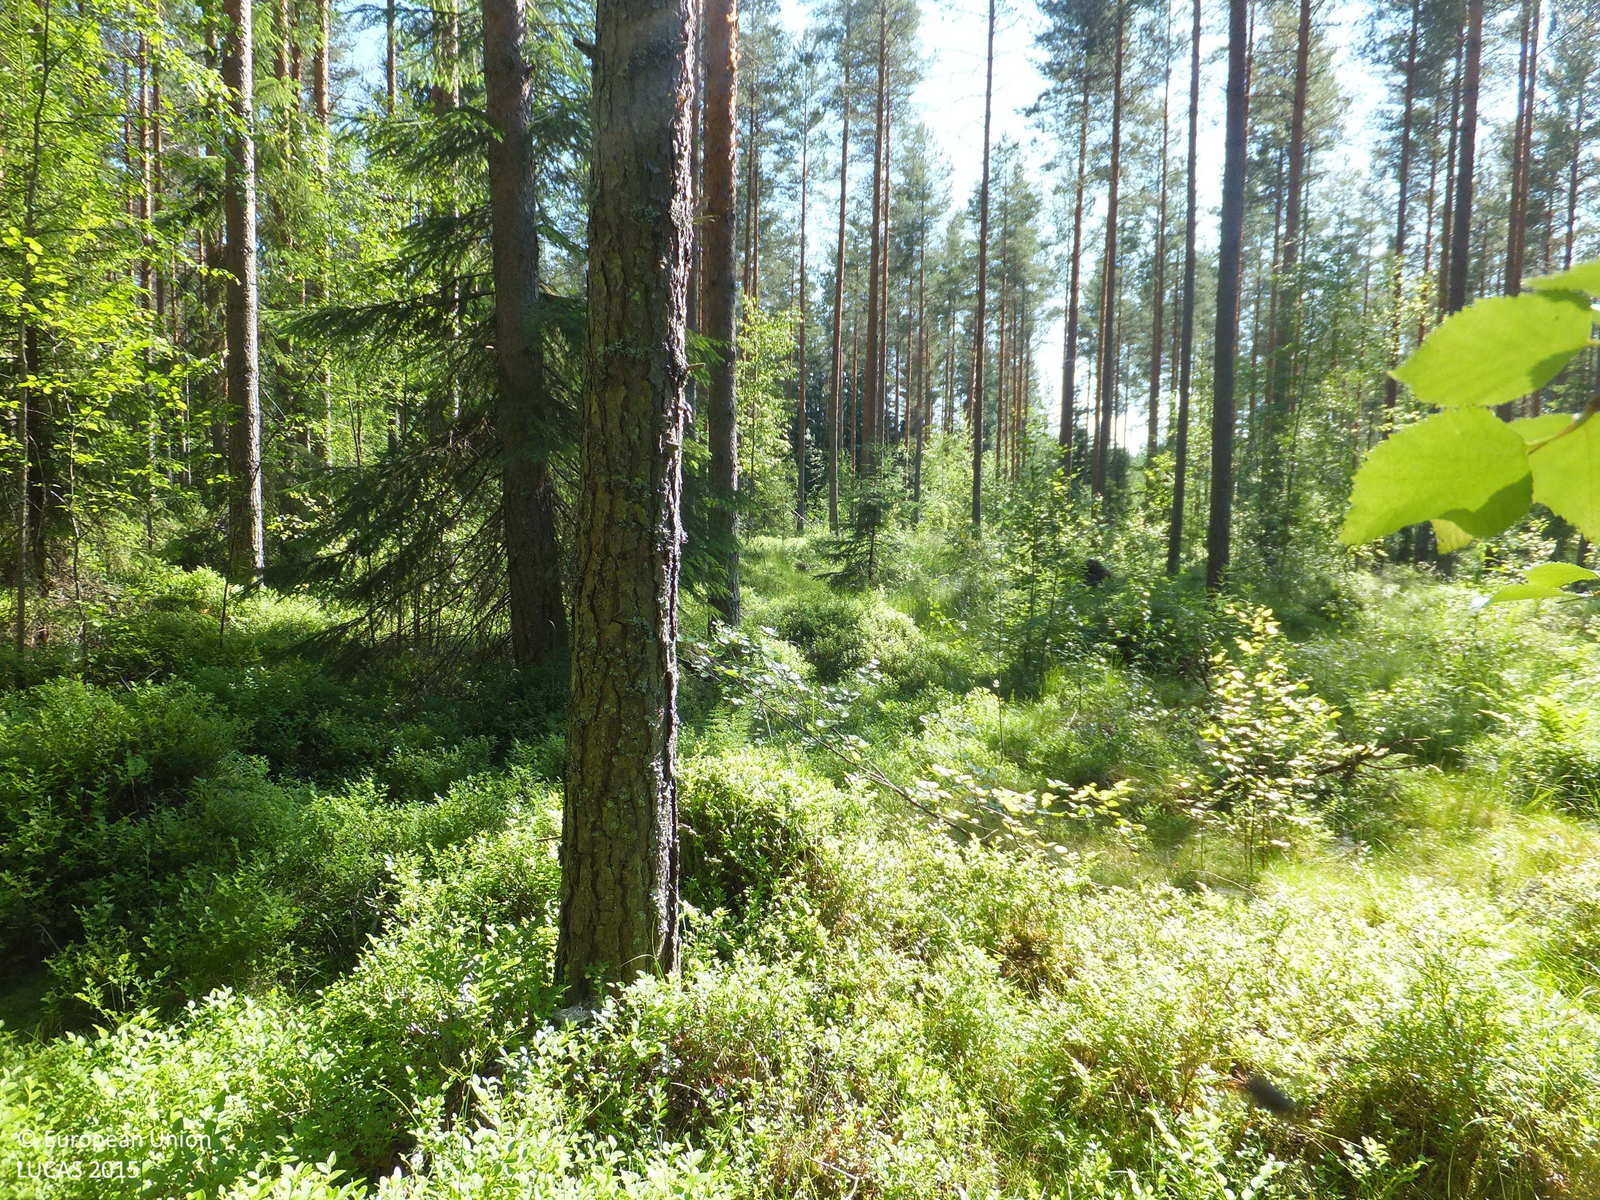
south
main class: Woodland
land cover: Pine dominated mixed woodland
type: boreal forest
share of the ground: > 75 %
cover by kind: coniferous forest trees 60 %, broadleaved forest trees 20 %, shrubs 10 %, herbaceous plants 5 %, lichens and mosses 5 %
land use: Forestry
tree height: > 5 m
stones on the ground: < 10 %
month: July
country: FI
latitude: 63.1603
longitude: 23.8690
